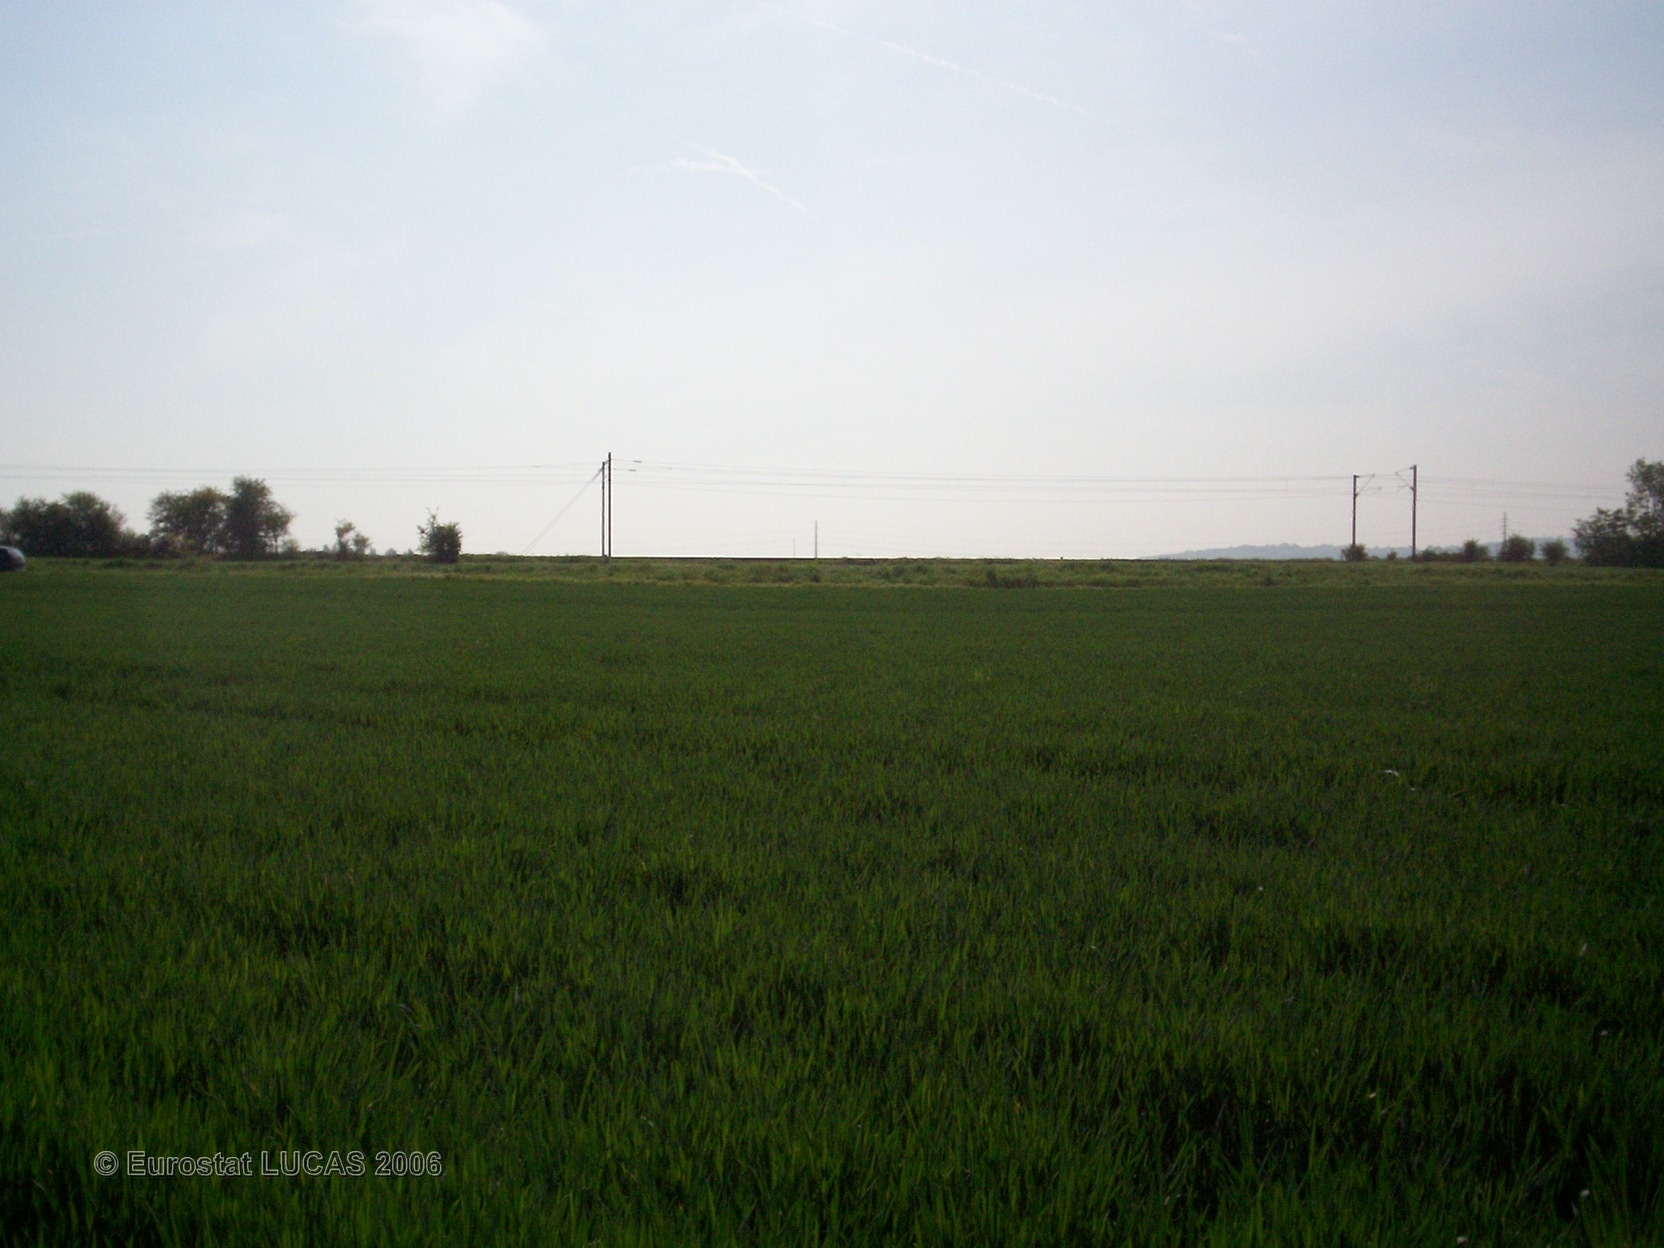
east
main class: Cropland
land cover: Common wheat
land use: Agriculture (excluding fallow land and kitchen gardens)
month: May
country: FR
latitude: 49.0667
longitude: 2.7218
